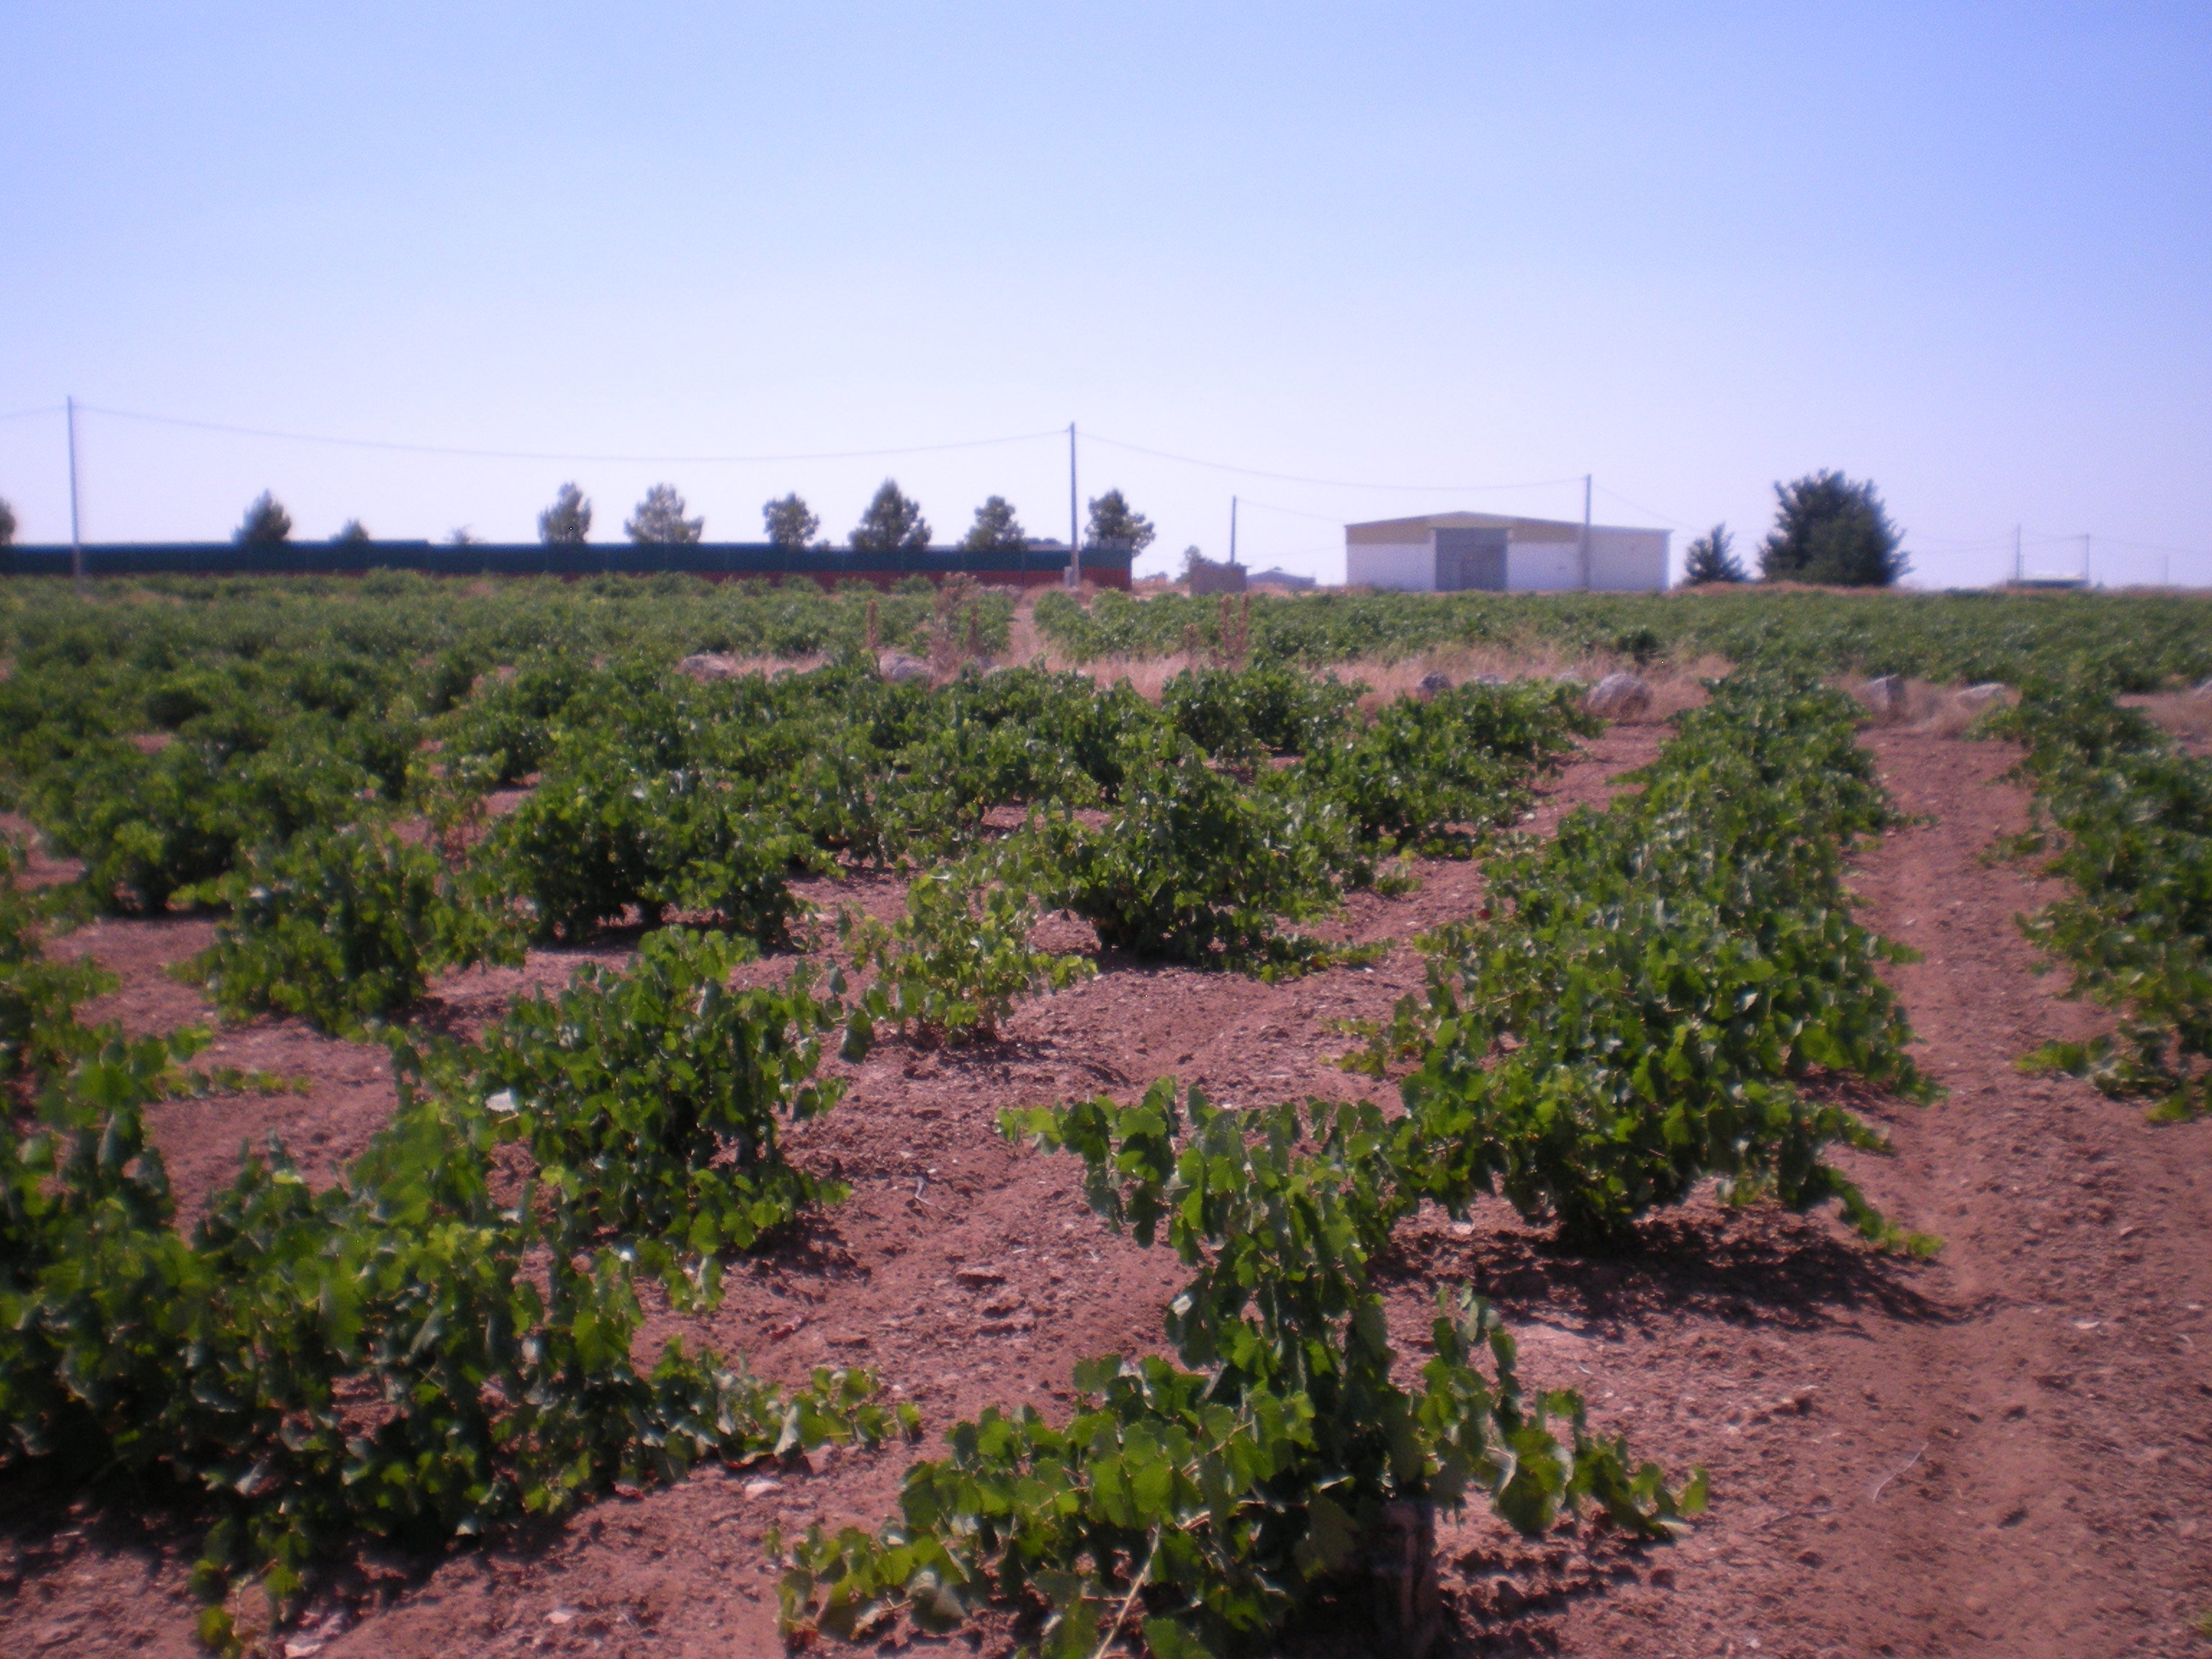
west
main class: Cropland
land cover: Vineyards
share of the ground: 10 - 25 %
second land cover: Other bare soil
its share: > 75 %
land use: Agriculture (excluding fallow land and kitchen gardens)
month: July
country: ES
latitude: 39.5156
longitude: -3.0804
